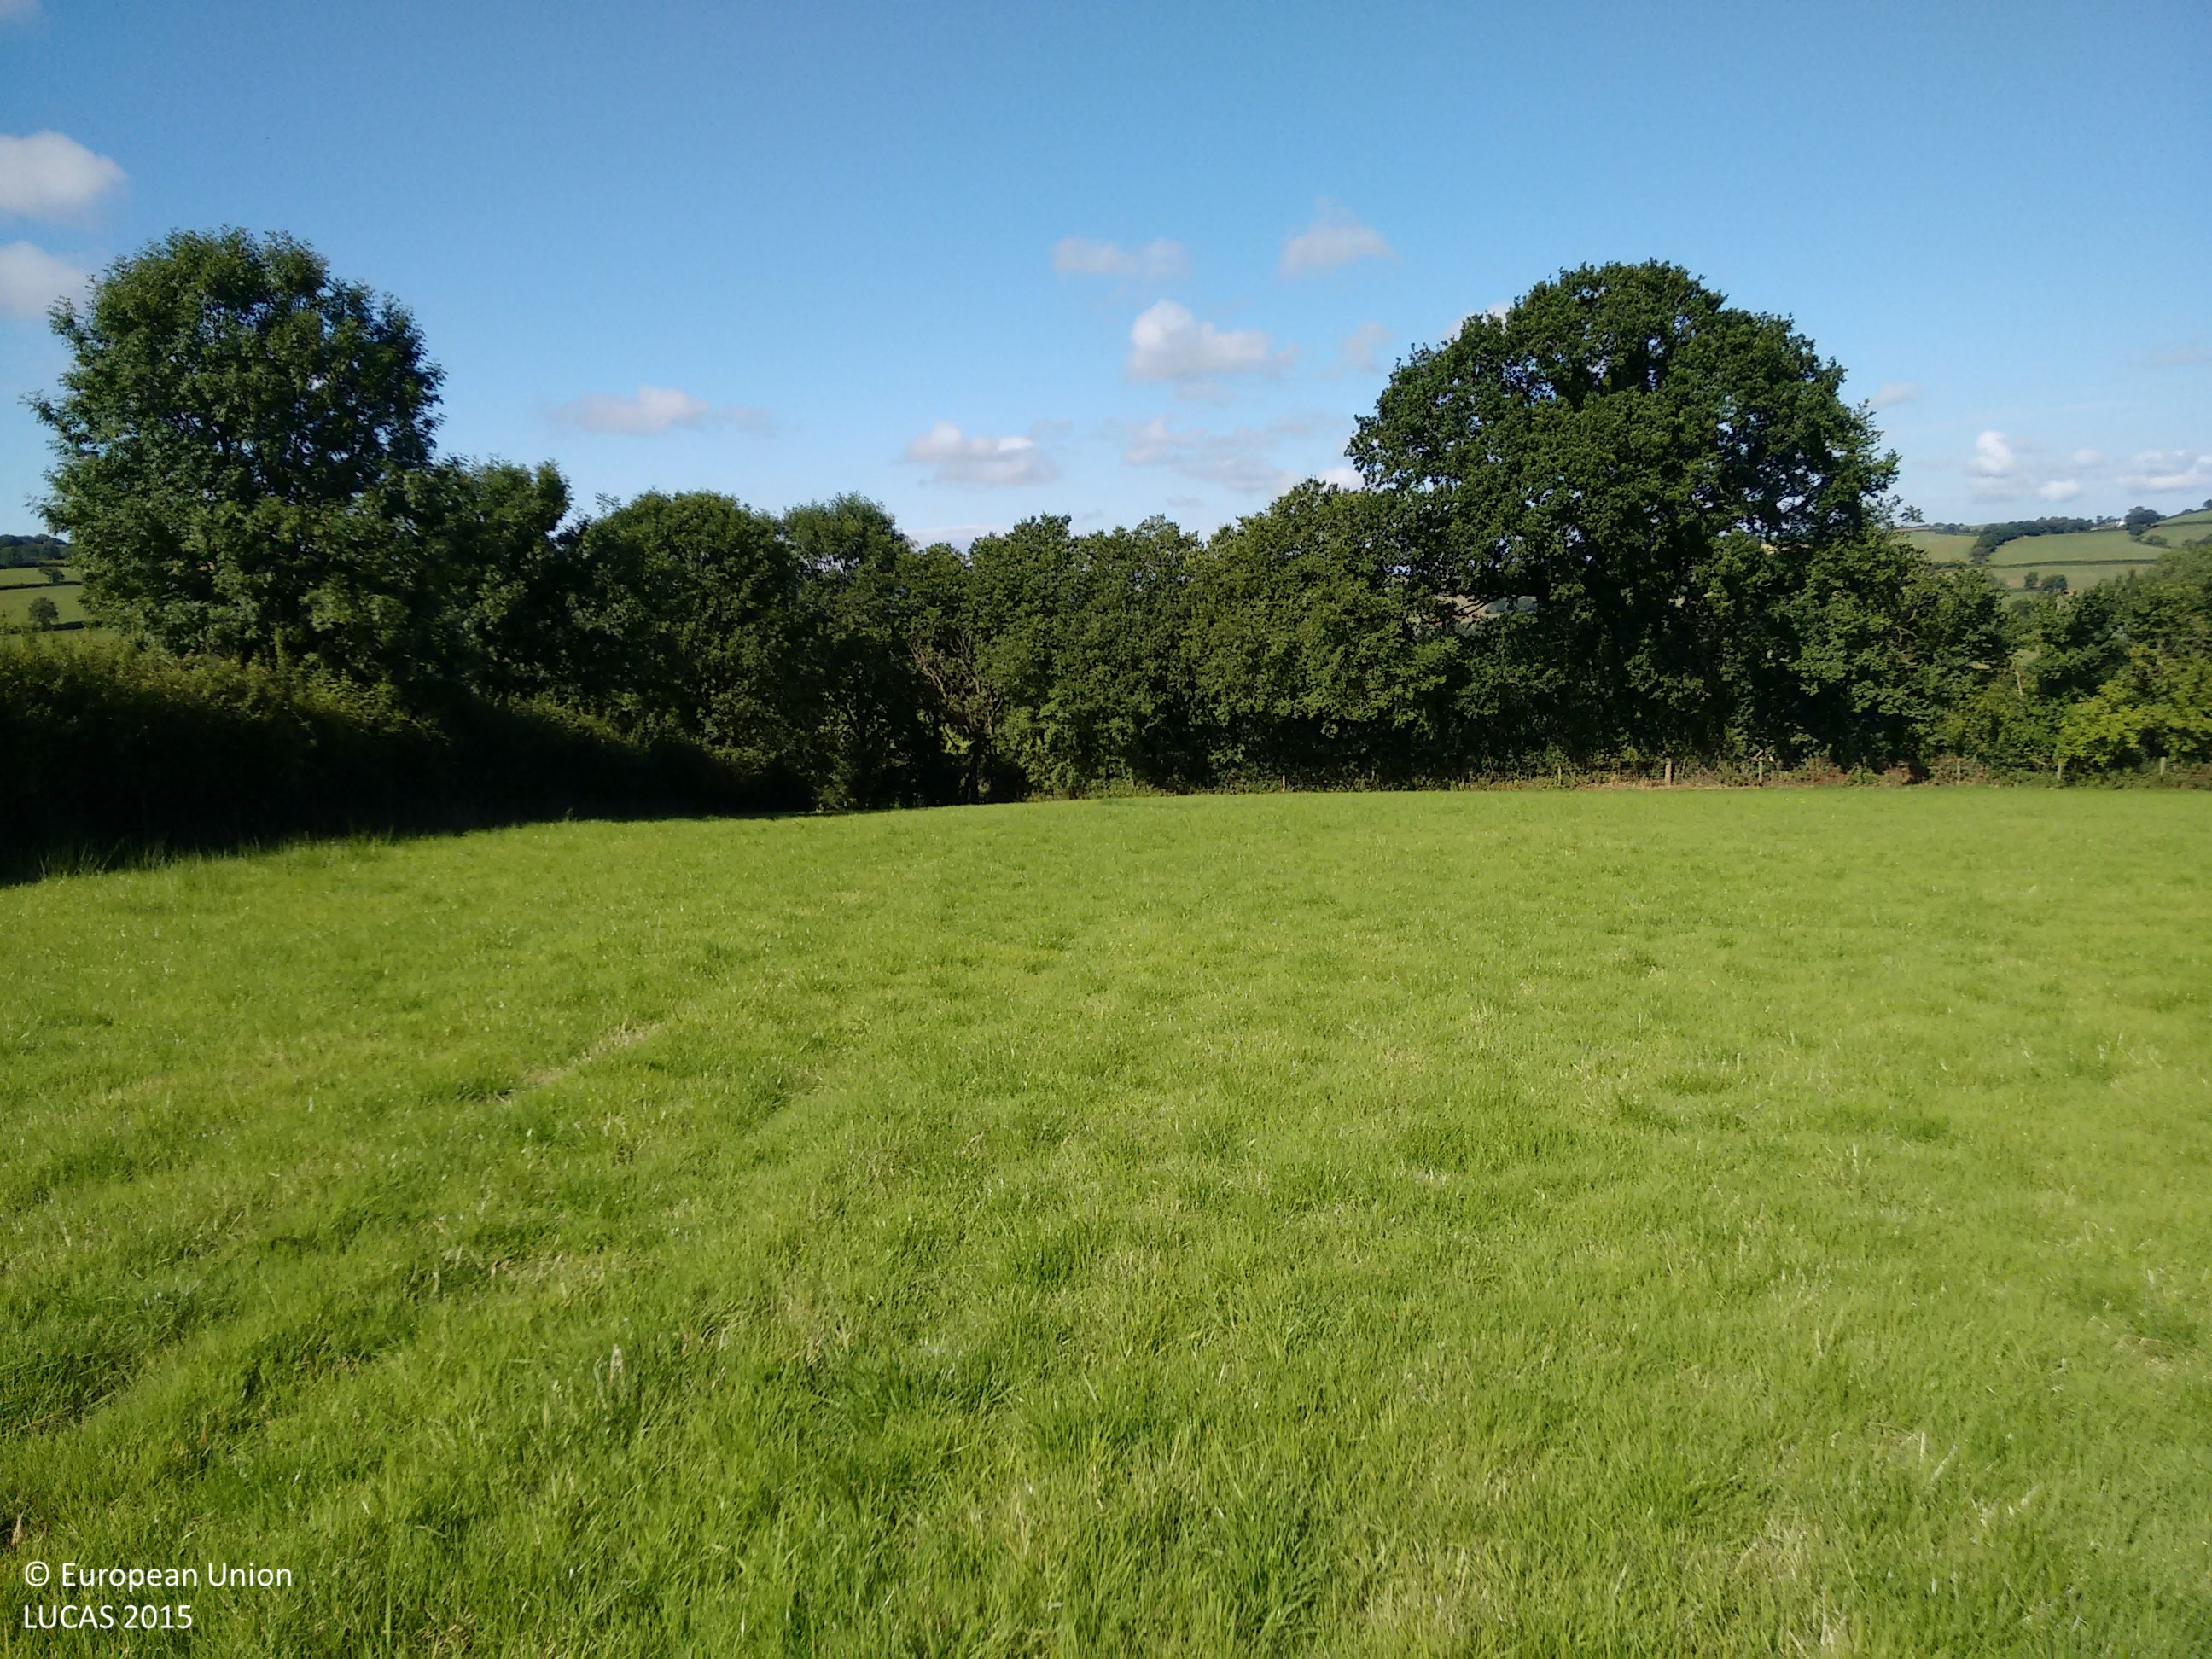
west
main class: Grassland
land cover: Grassland without tree/shrub cover
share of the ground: > 75 %
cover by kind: herbaceous plants 100 %
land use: Agriculture (excluding fallow land and kitchen gardens)
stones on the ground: < 10 %
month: August
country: GB
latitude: 50.8595
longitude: -3.4517
